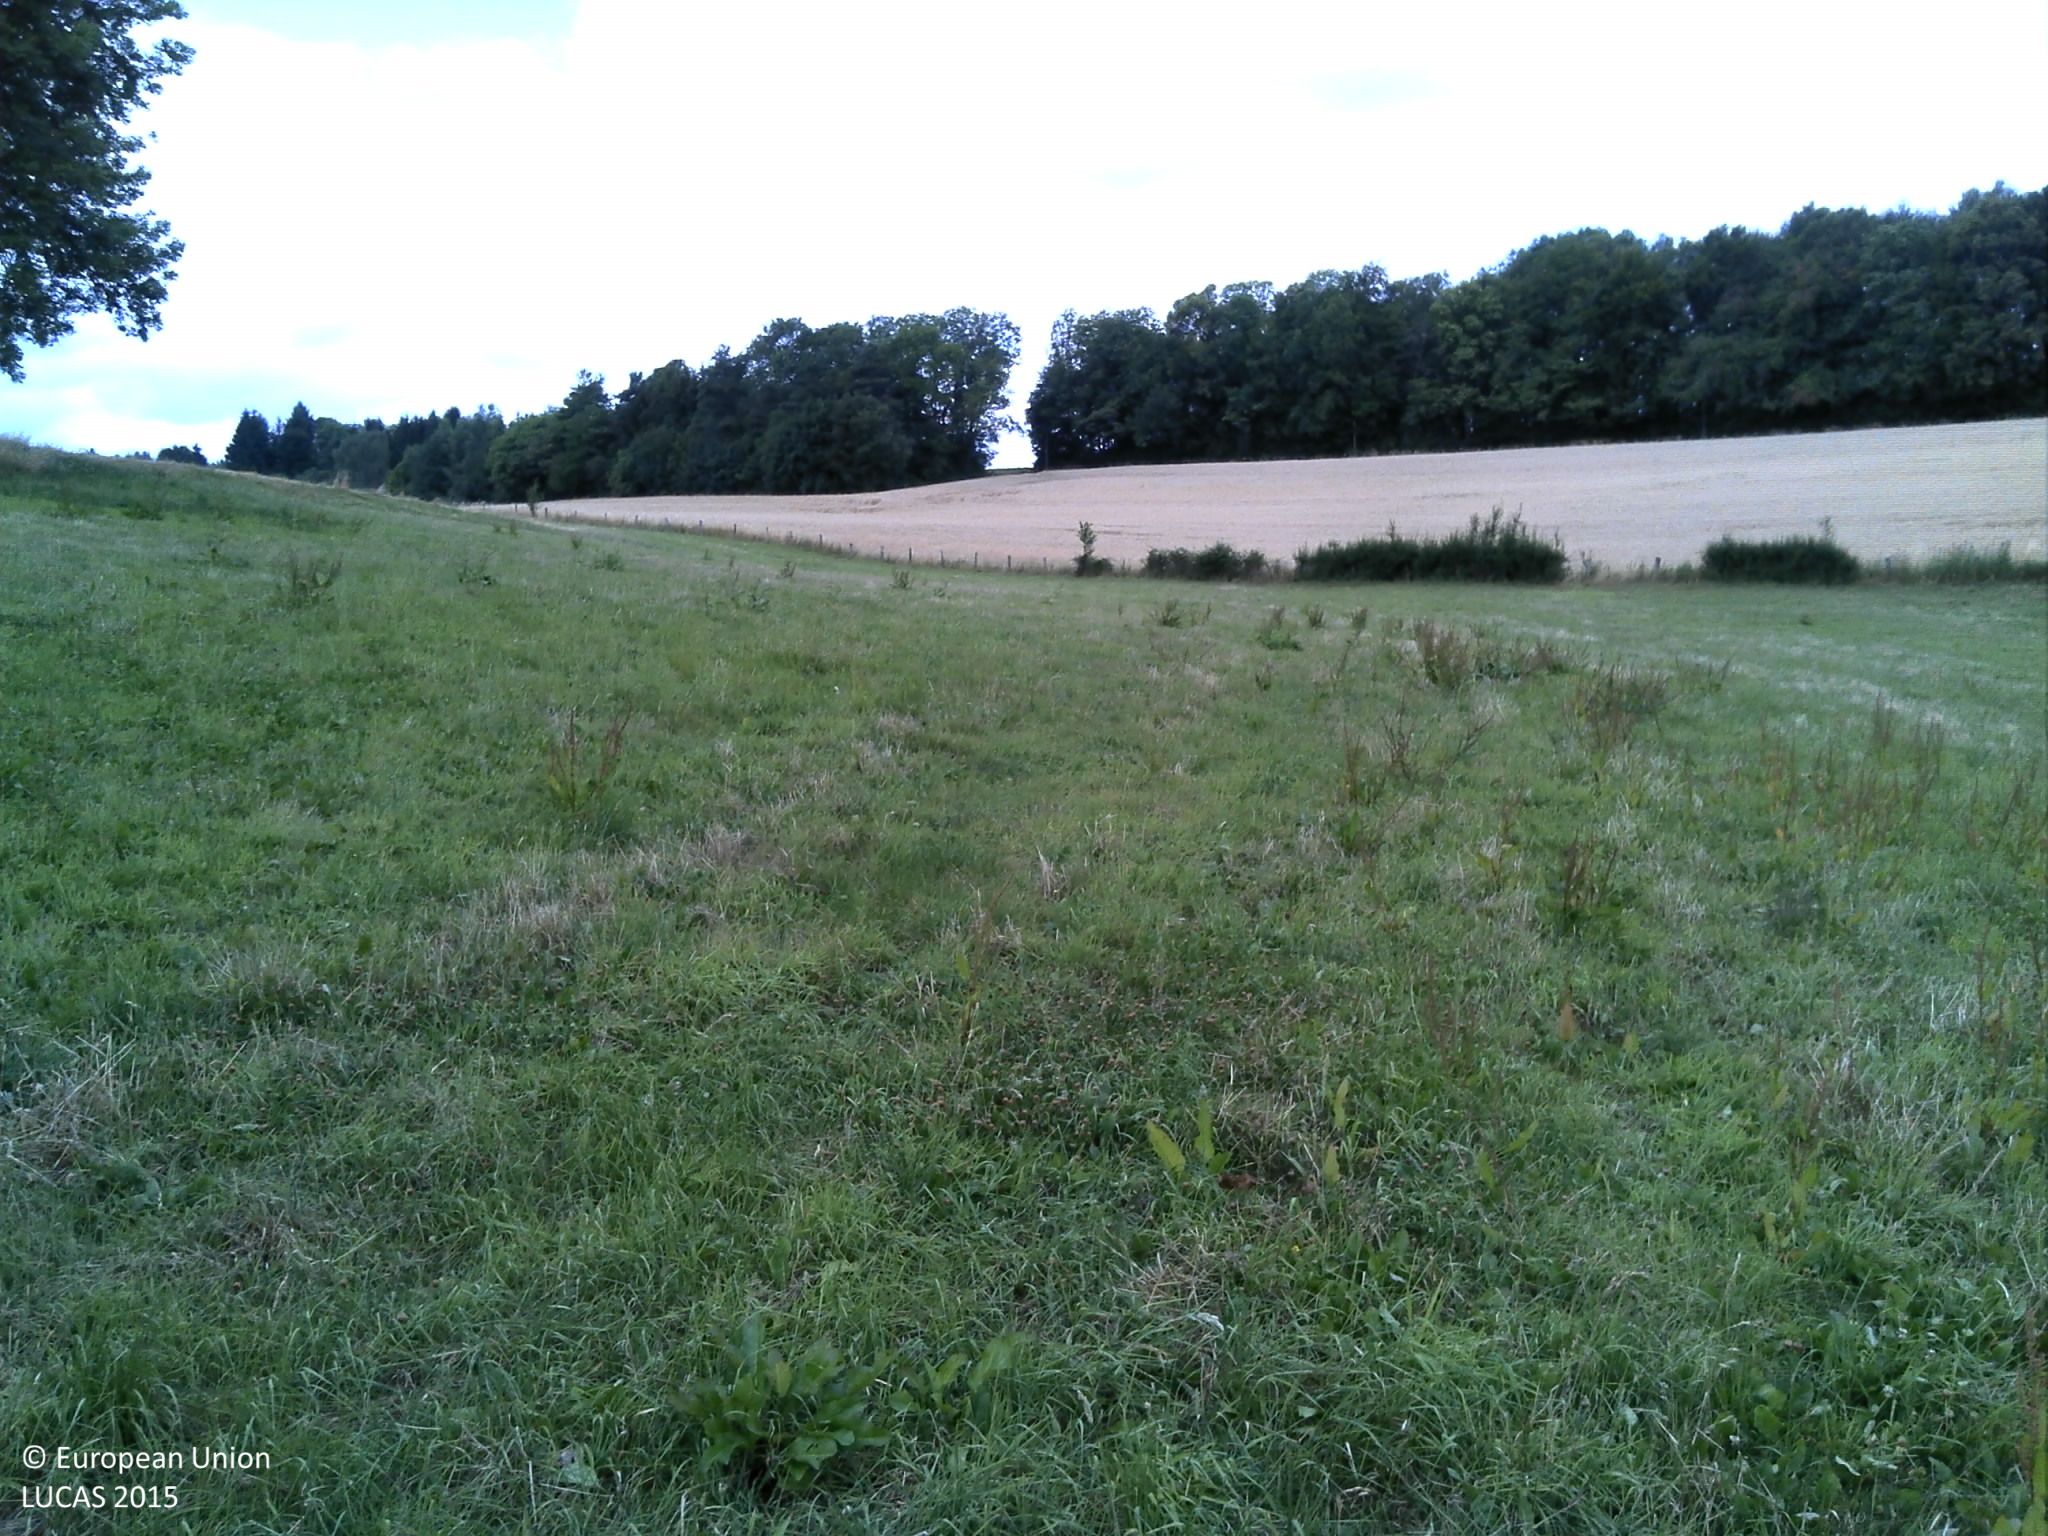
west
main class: Grassland
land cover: Grassland without tree/shrub cover
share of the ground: > 75 %
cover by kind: herbaceous plants 100 %
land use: Agriculture (excluding fallow land and kitchen gardens)
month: July
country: FR
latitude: 48.1625
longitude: 6.3302
